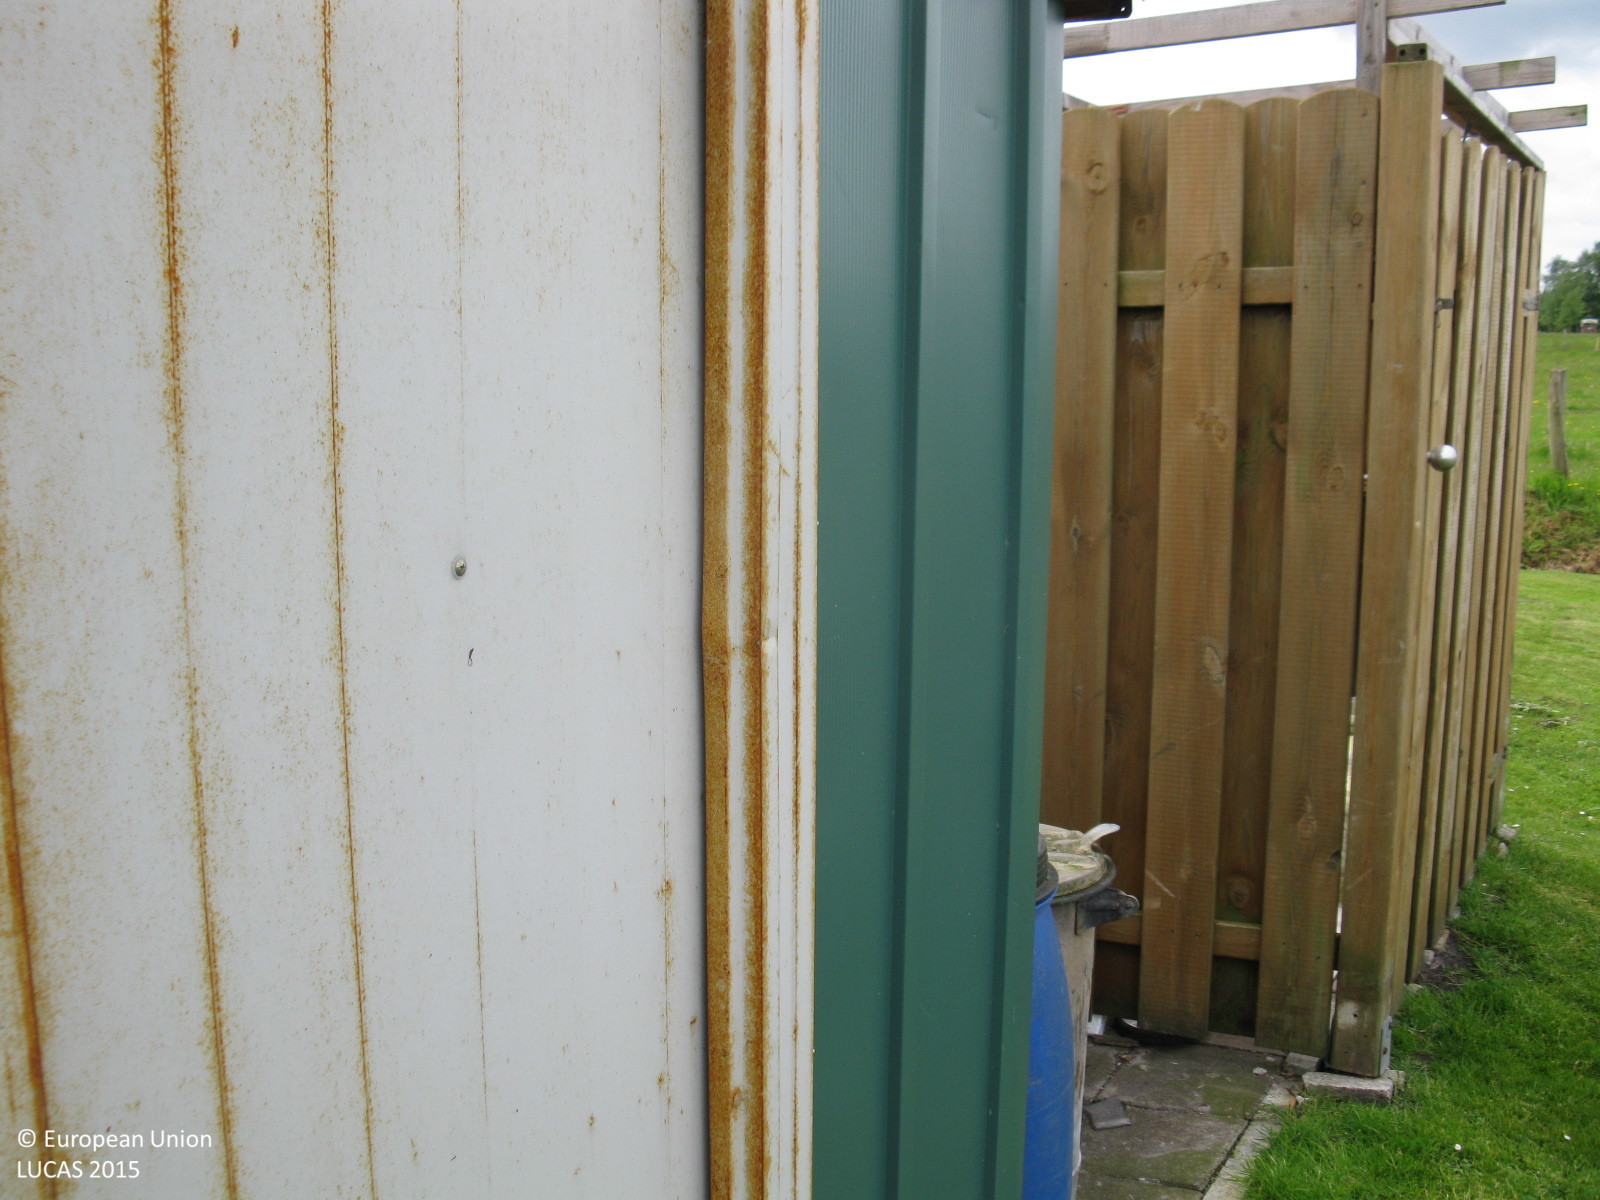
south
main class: Grassland
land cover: Grassland without tree/shrub cover
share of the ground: > 75 %
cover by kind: herbaceous plants 100 %
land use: Agriculture (excluding fallow land and kitchen gardens)
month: June
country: DE
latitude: 53.1739
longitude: 7.2926
